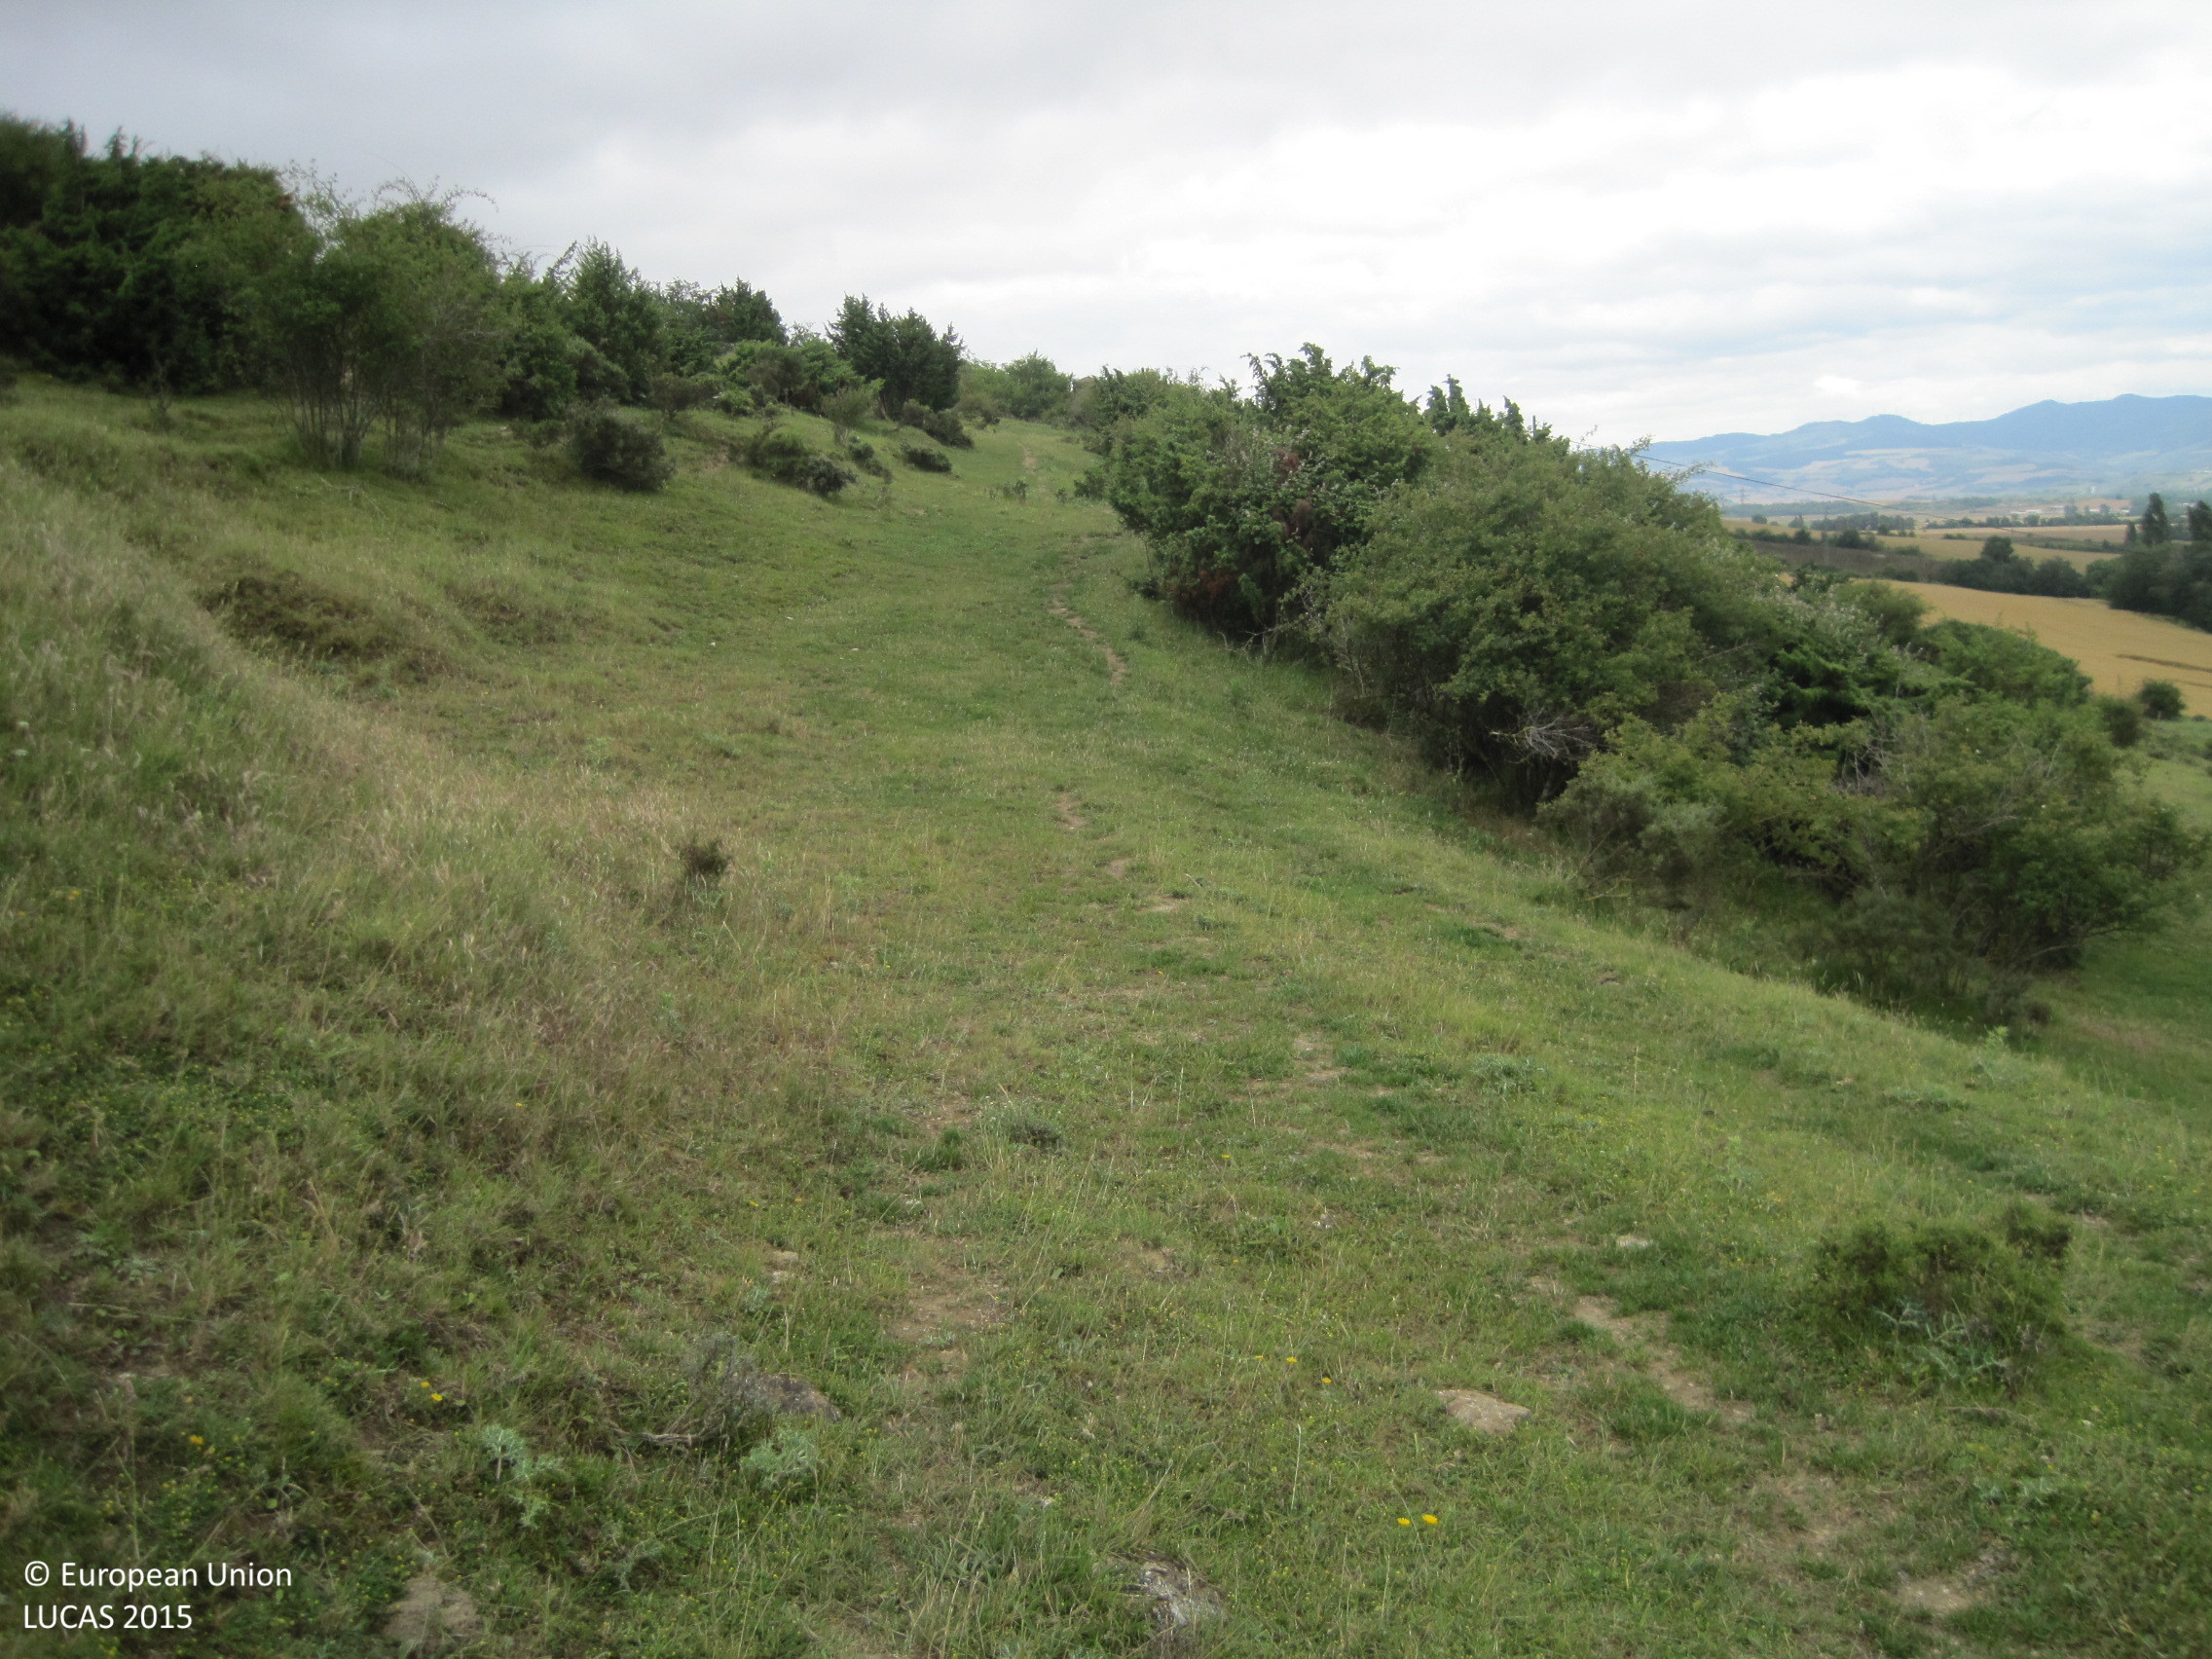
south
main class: Shrubland
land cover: Shrubland without tree cover
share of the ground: > 75 %
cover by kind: herbaceous plants 80 %, shrubs 20 %
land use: Agriculture (excluding fallow land and kitchen gardens)
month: June
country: ES
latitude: 42.8604
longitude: -1.7534
